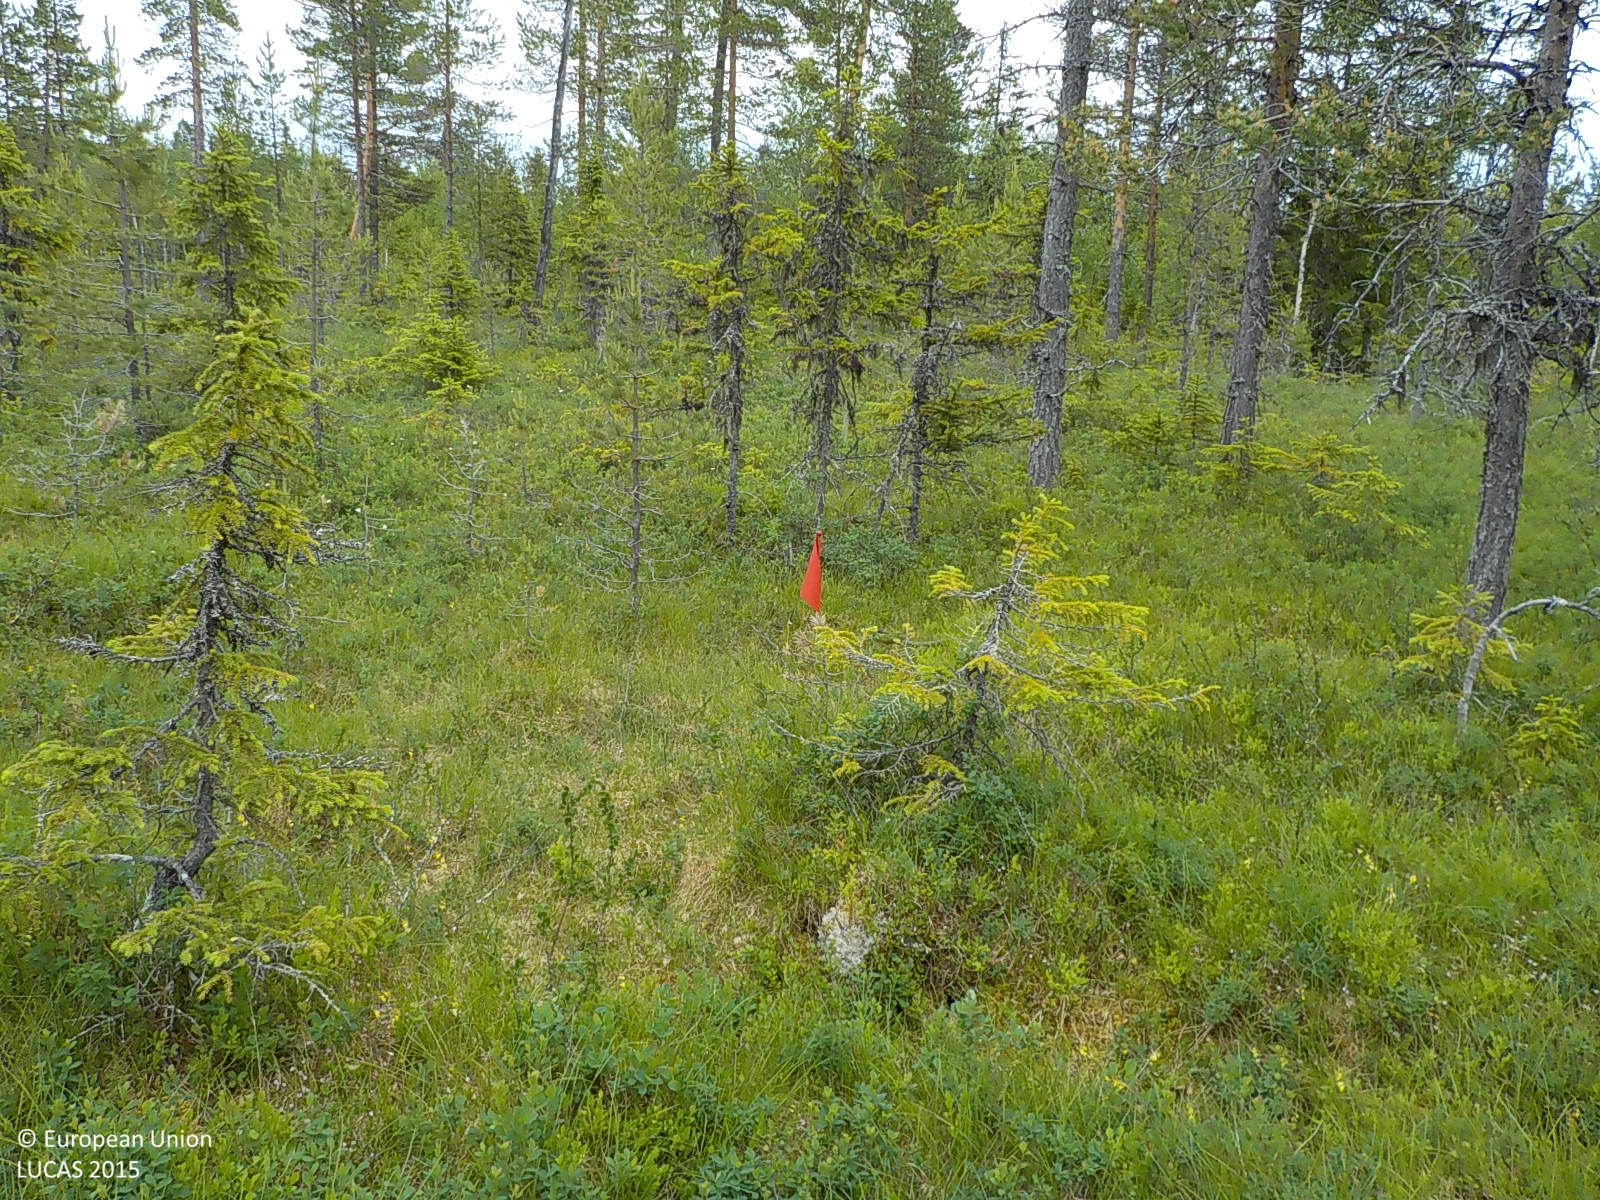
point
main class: Woodland
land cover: Spruce dominated coniferous woodland
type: boreal forest
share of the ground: 50 - 75 %
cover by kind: coniferous forest trees 50 %, shrubs 25 %, herbaceous plants 20 %, broadleaved forest trees 5 %
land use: Semi-natural and natural areas not in use
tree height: < 5 m
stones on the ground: < 10 %
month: July
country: SE
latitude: 63.1725
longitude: 16.6290
